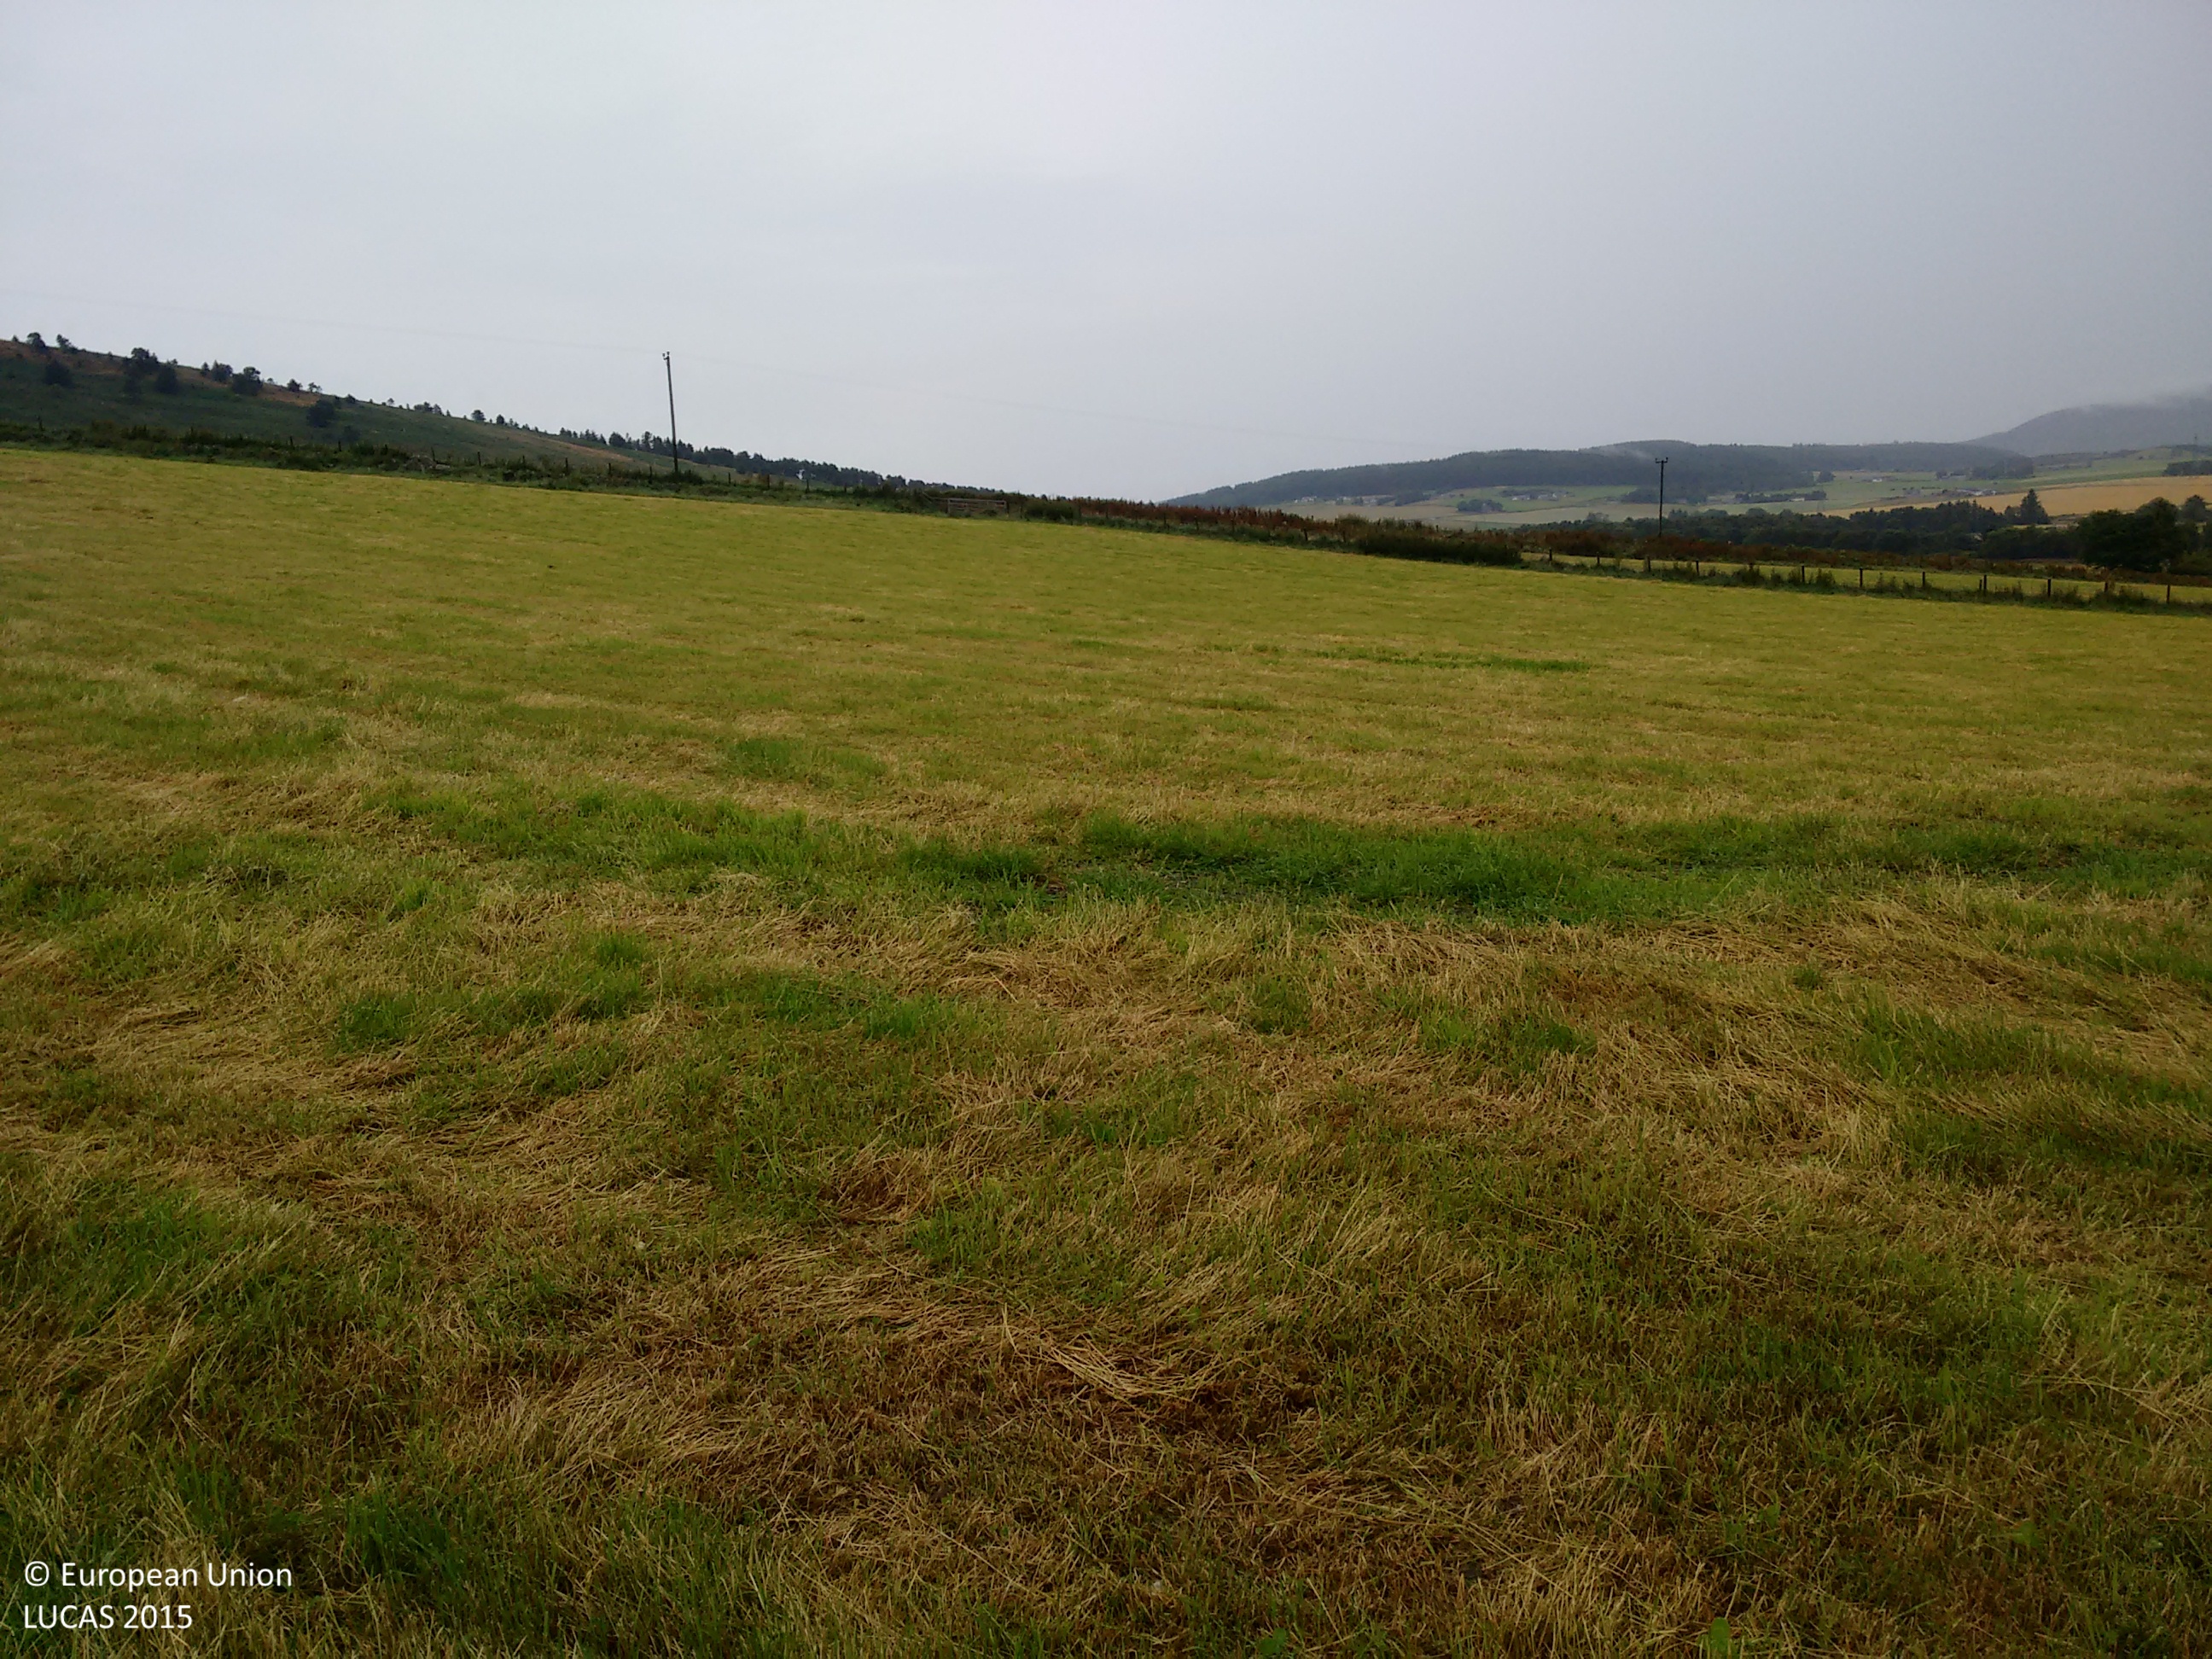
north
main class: Cropland
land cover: Temporary grasslands
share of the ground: > 75 %
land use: Agriculture (excluding fallow land and kitchen gardens)
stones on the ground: < 10 %
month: August
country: GB
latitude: 57.5279
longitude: -2.8336
